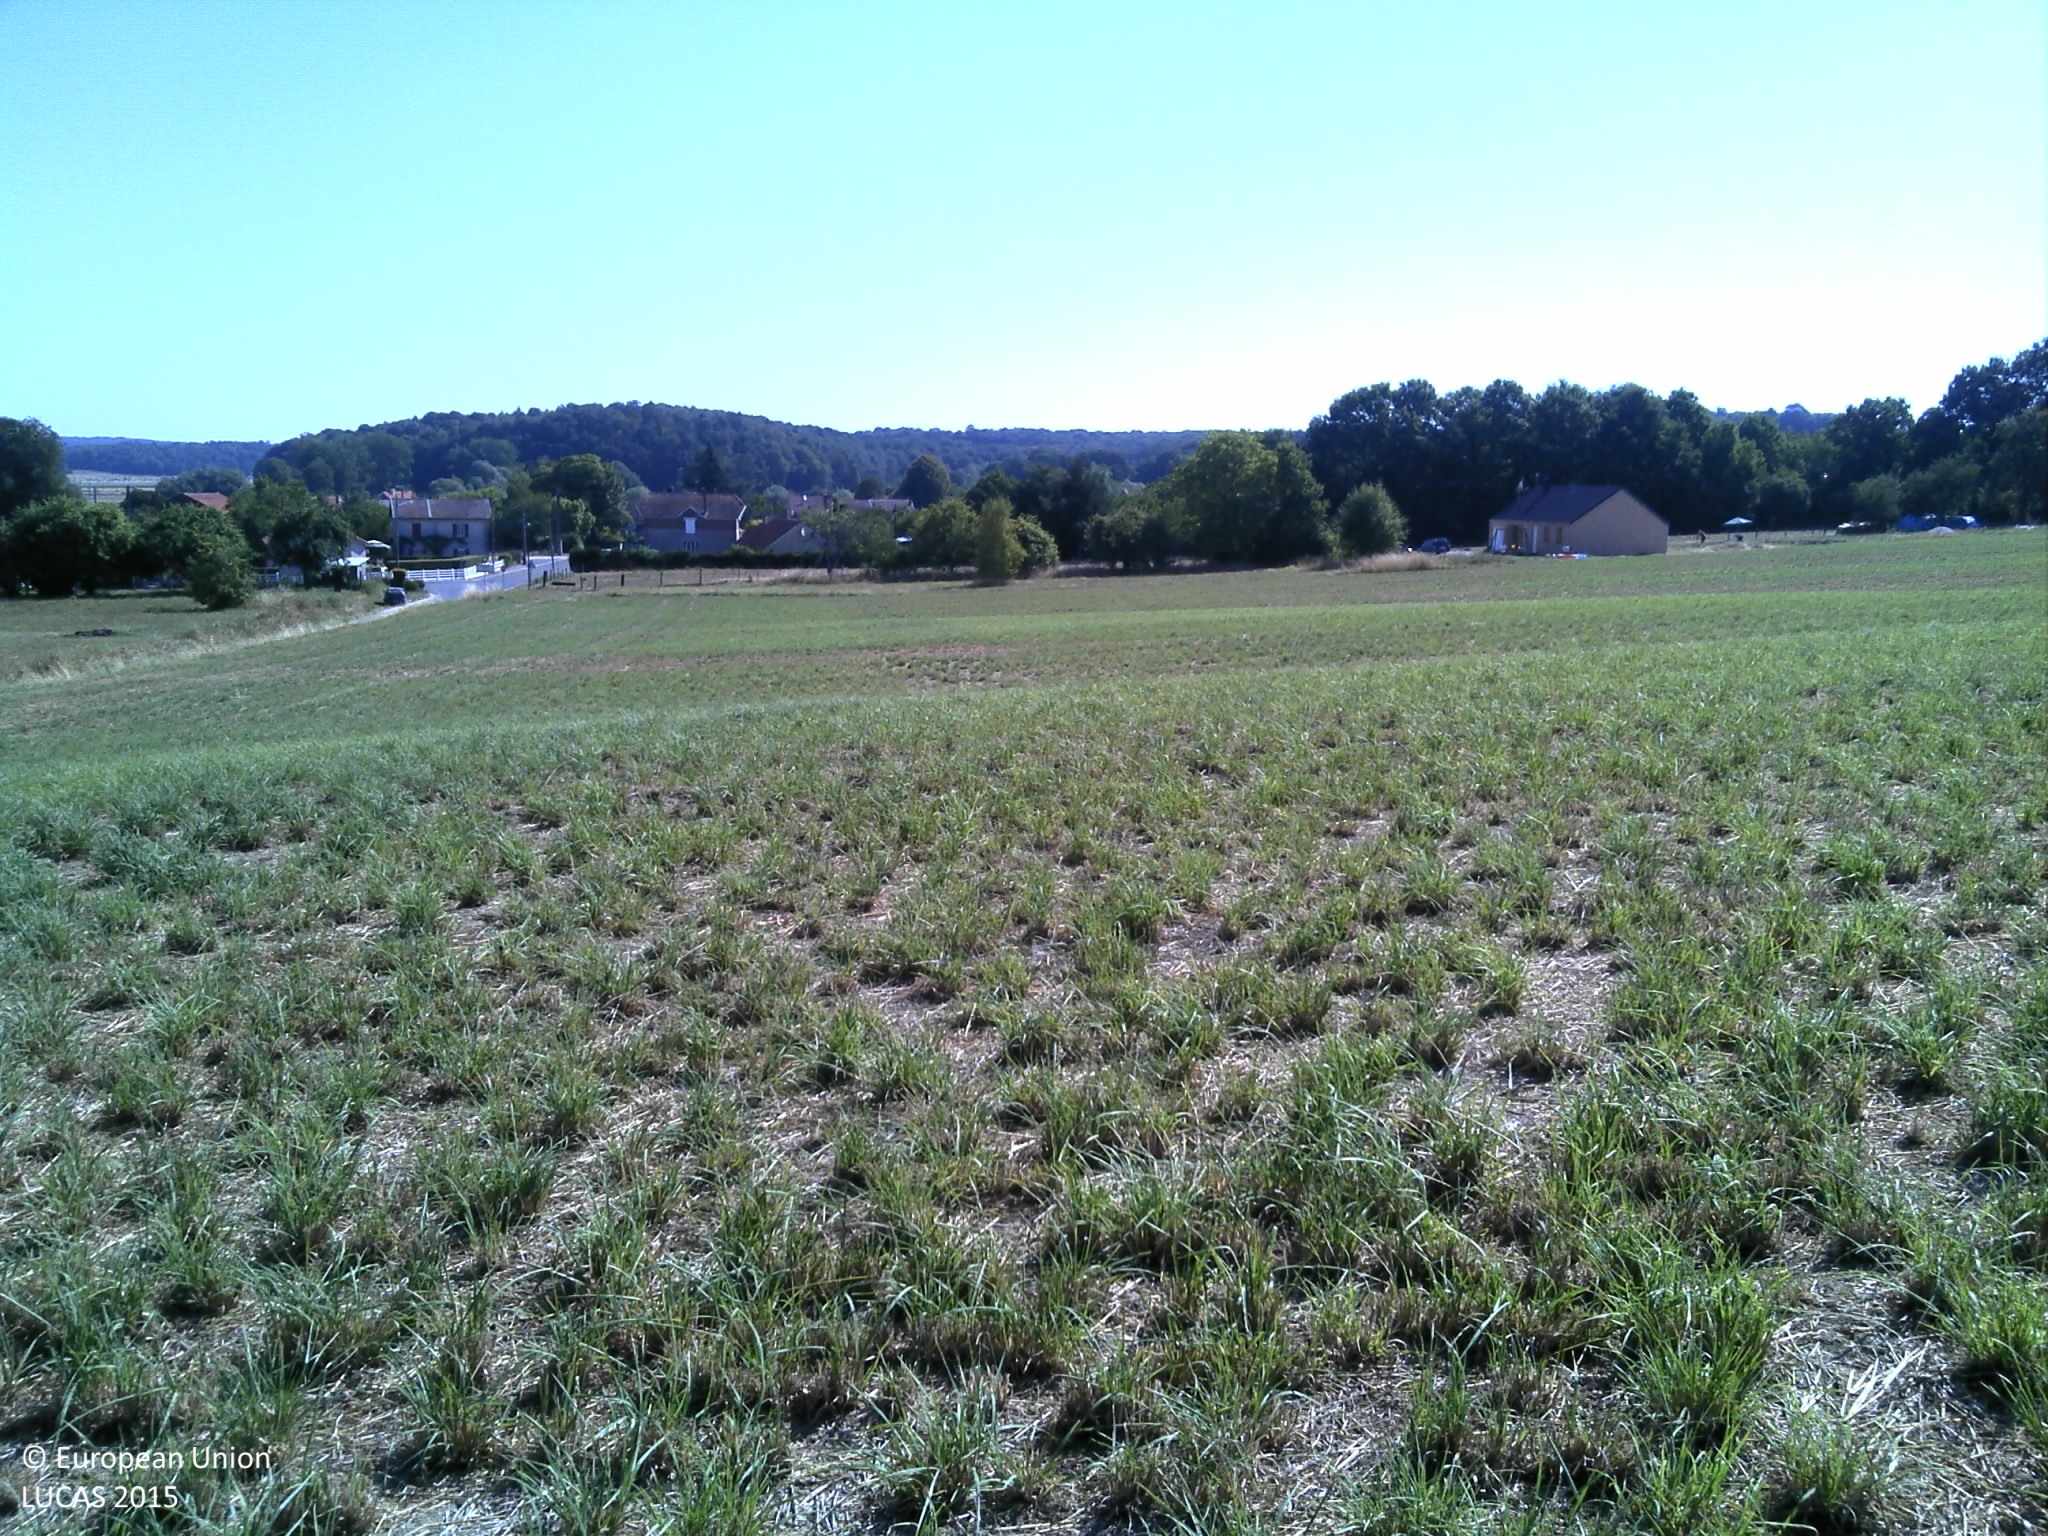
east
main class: Cropland
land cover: Temporary grasslands
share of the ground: > 75 %
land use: Agriculture (excluding fallow land and kitchen gardens)
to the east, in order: Temporary grasslands; Artificial constructions in urban areas; Grassland without tree/shrub cover; Fences; Broadleaved woodland
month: August
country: FR
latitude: 49.1670
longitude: 4.8543
